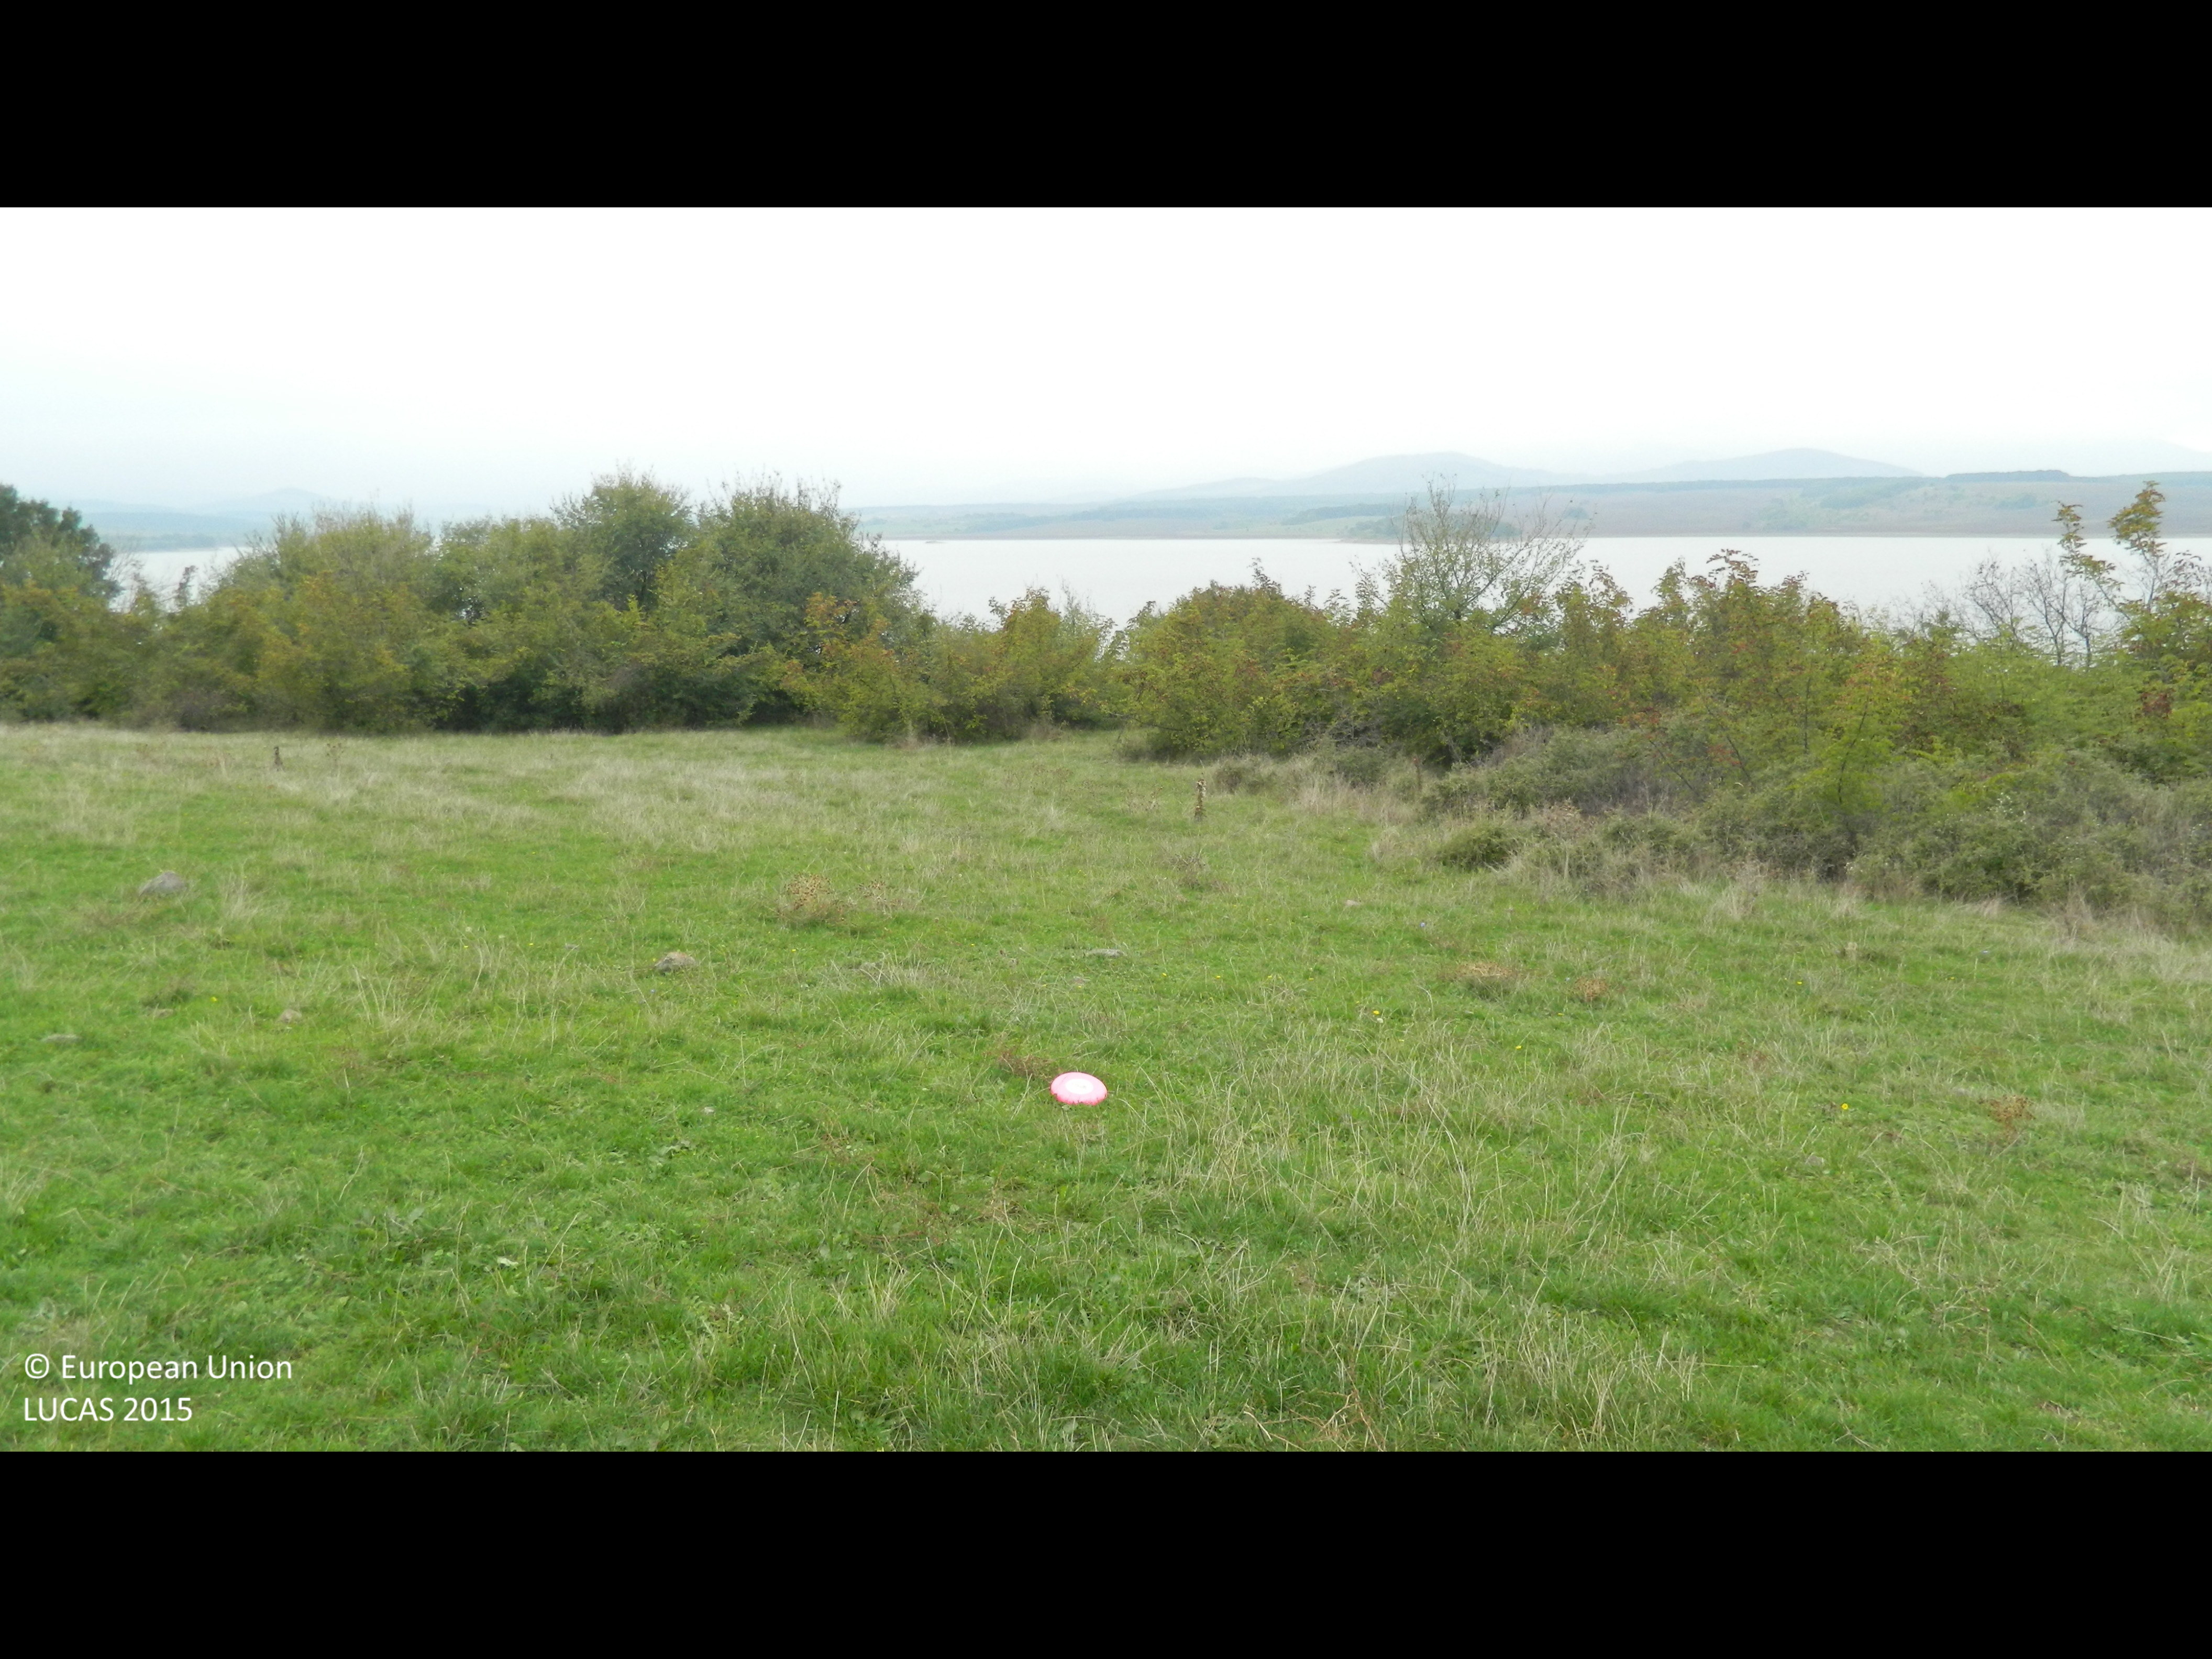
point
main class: Grassland
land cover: Grassland without tree/shrub cover
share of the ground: > 75 %
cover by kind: herbaceous plants 100 %
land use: Agriculture (excluding fallow land and kitchen gardens)
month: October
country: BG
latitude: 41.8508
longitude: 25.4174
